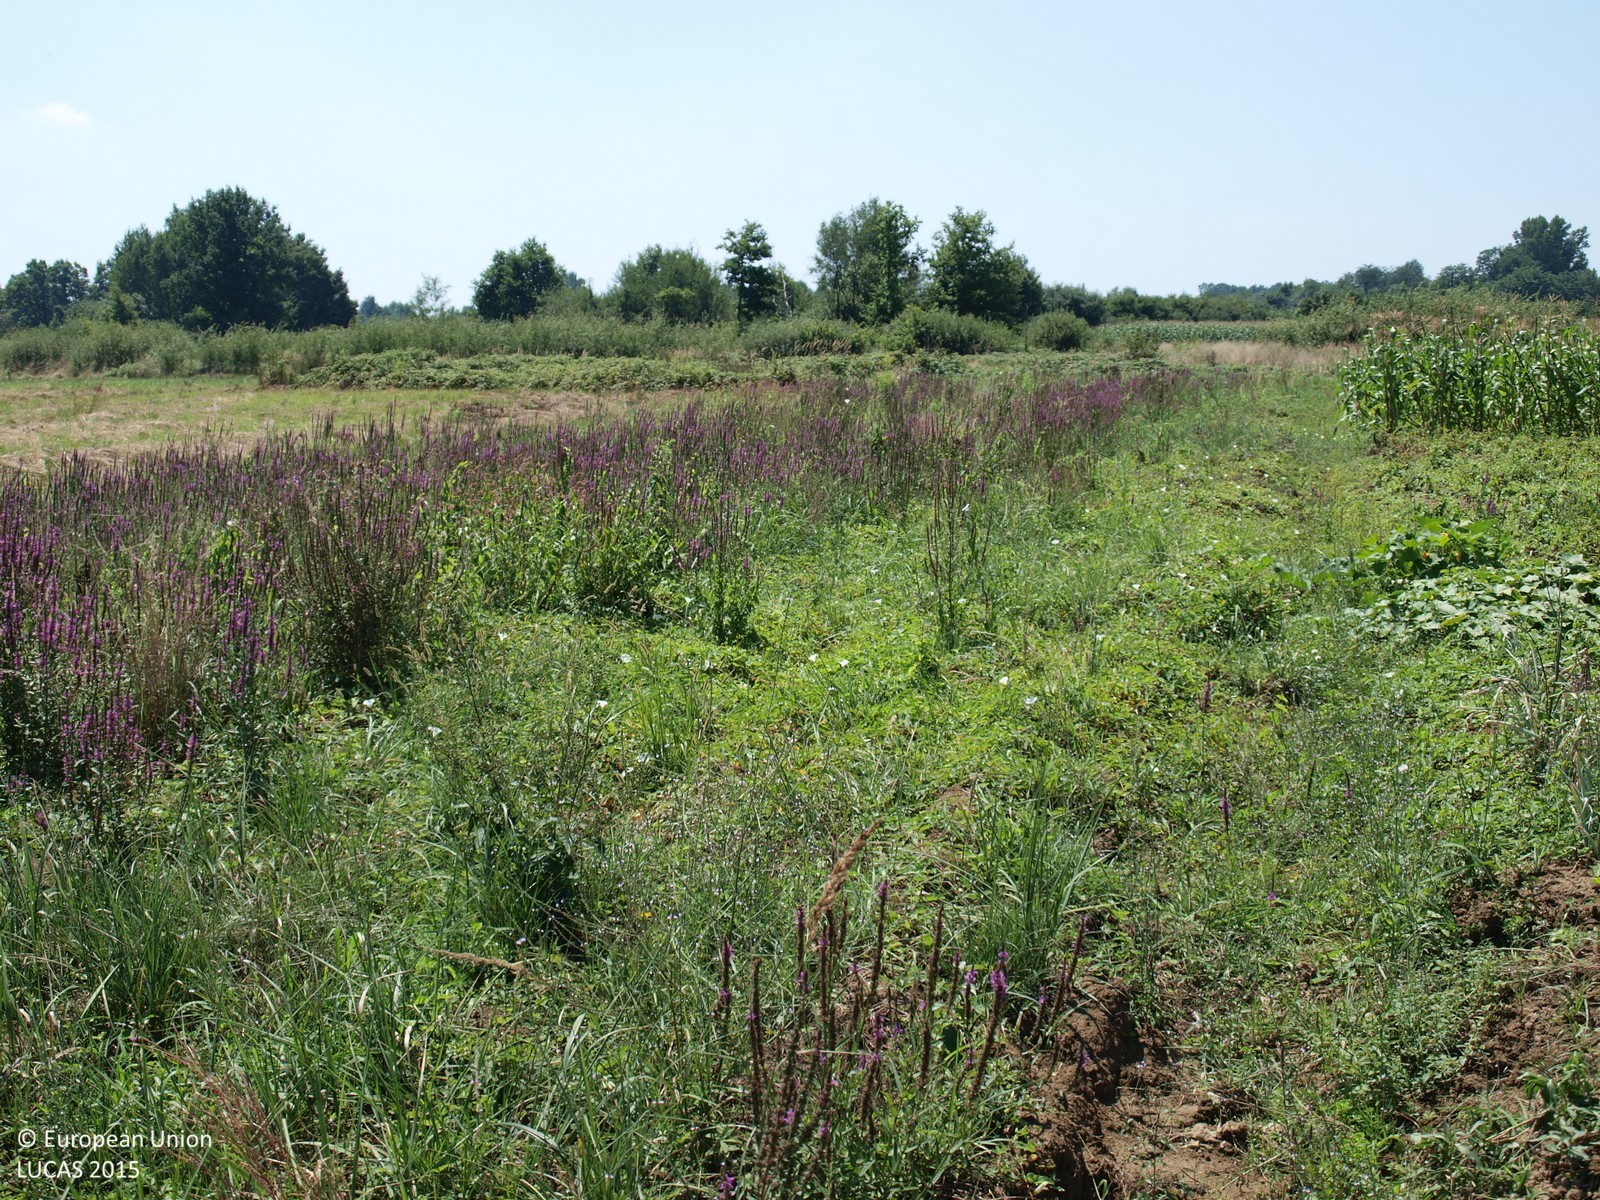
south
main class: Cropland
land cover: Other root crops
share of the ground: > 75 %
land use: Kitchen garden
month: August
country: HR
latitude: 45.8421
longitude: 16.2692
